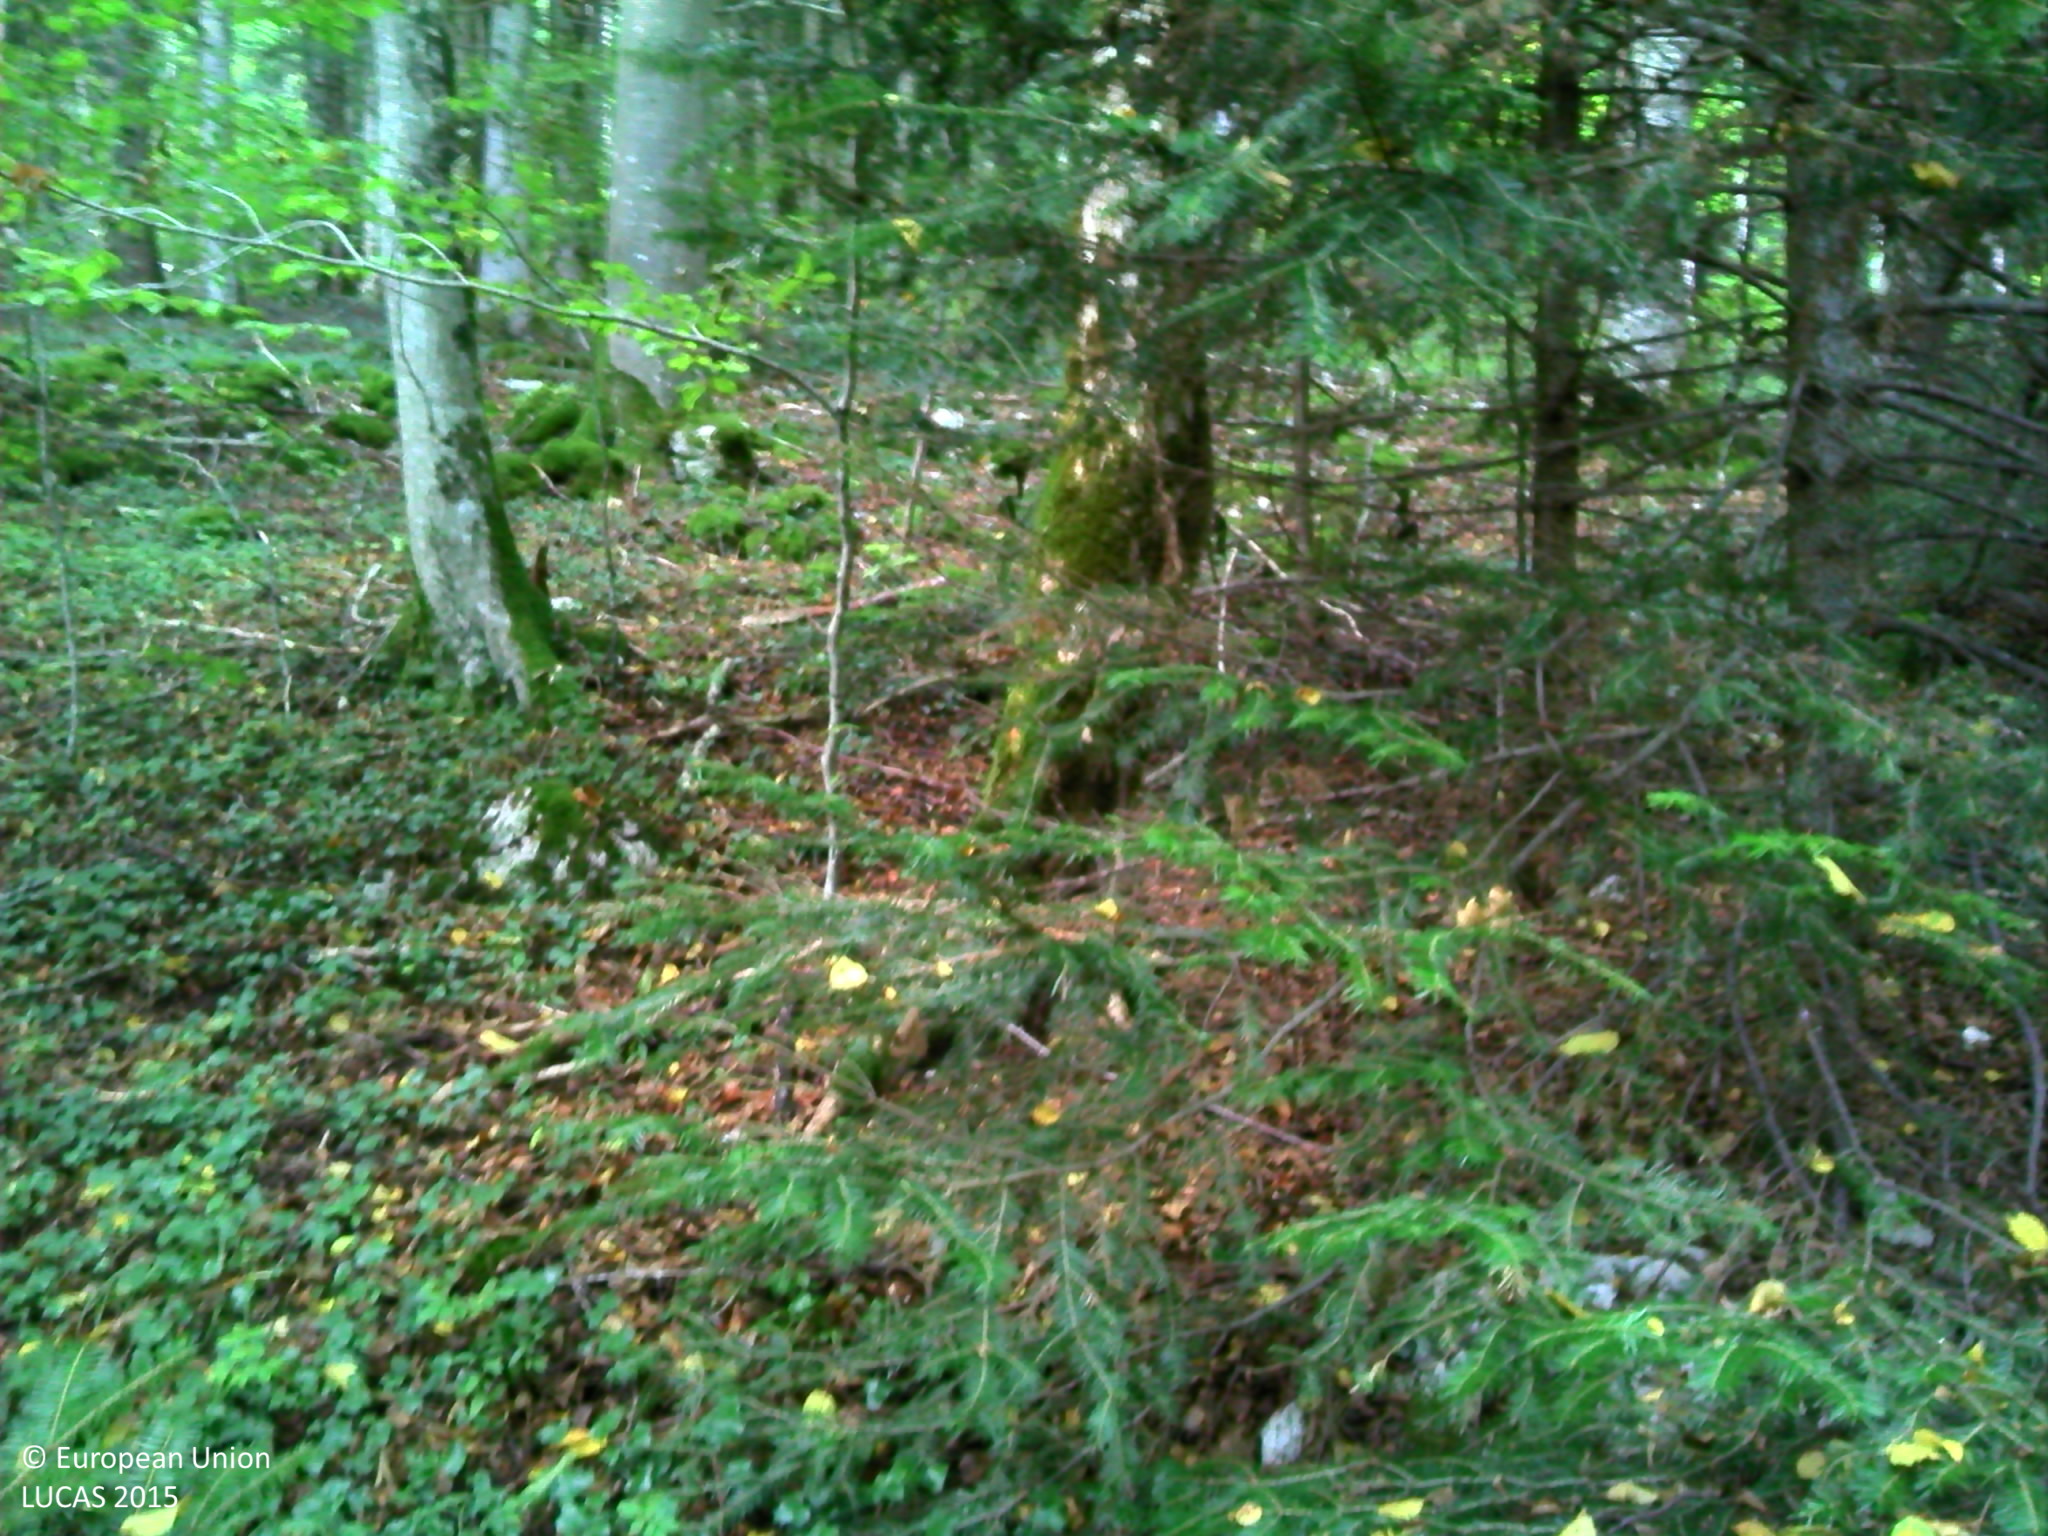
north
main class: Woodland
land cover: Broadleaved woodland
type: beech forest
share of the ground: > 75 %
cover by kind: broadleaved forest trees 75 %, unconsolidated bare surface 15 %, coniferous forest trees 5 %, lichens and mosses 5 %
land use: Forestry
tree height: > 5 m
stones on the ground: < 10 %
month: September
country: FR
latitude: 47.3534
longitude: 6.9703
